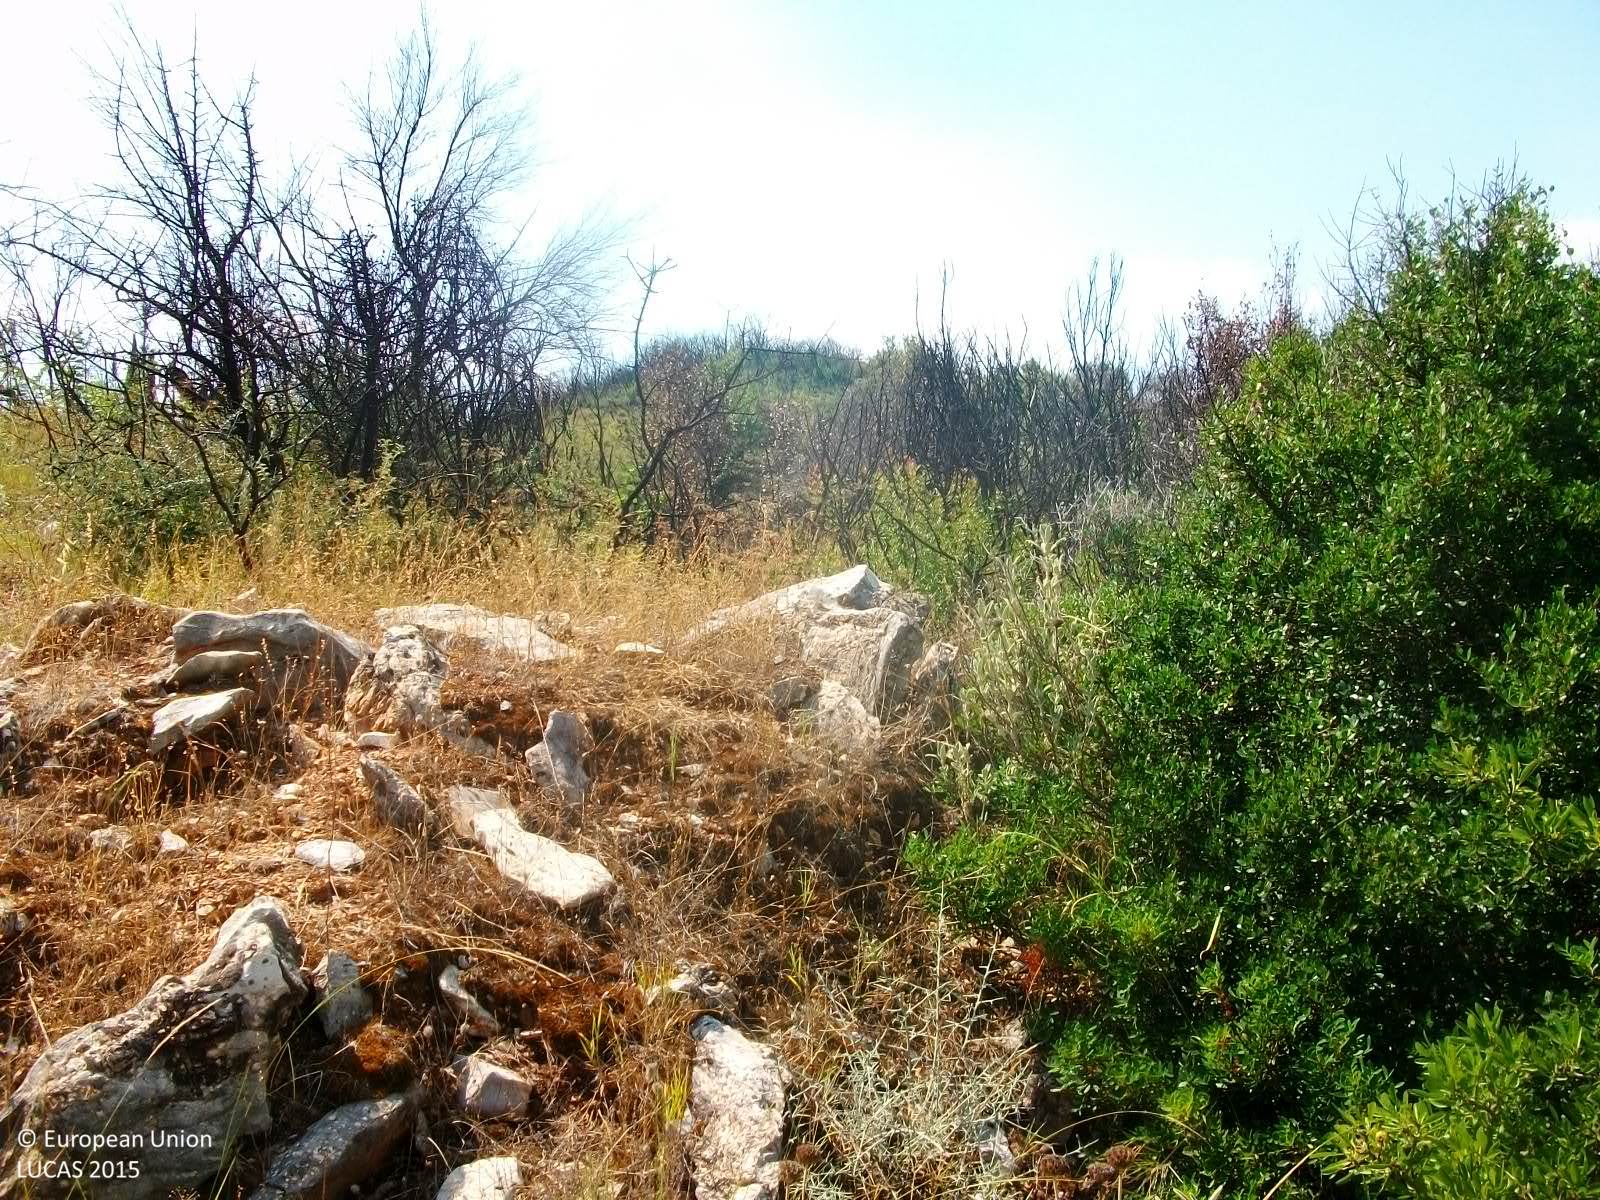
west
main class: Shrubland
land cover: Shrubland with sparse tree cover
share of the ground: > 75 %
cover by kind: shrubs 95 %, broadleaved forest trees 5 %
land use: Semi-natural and natural areas not in use
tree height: > 5 m
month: August
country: GR
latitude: 37.1979
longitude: 21.9082
